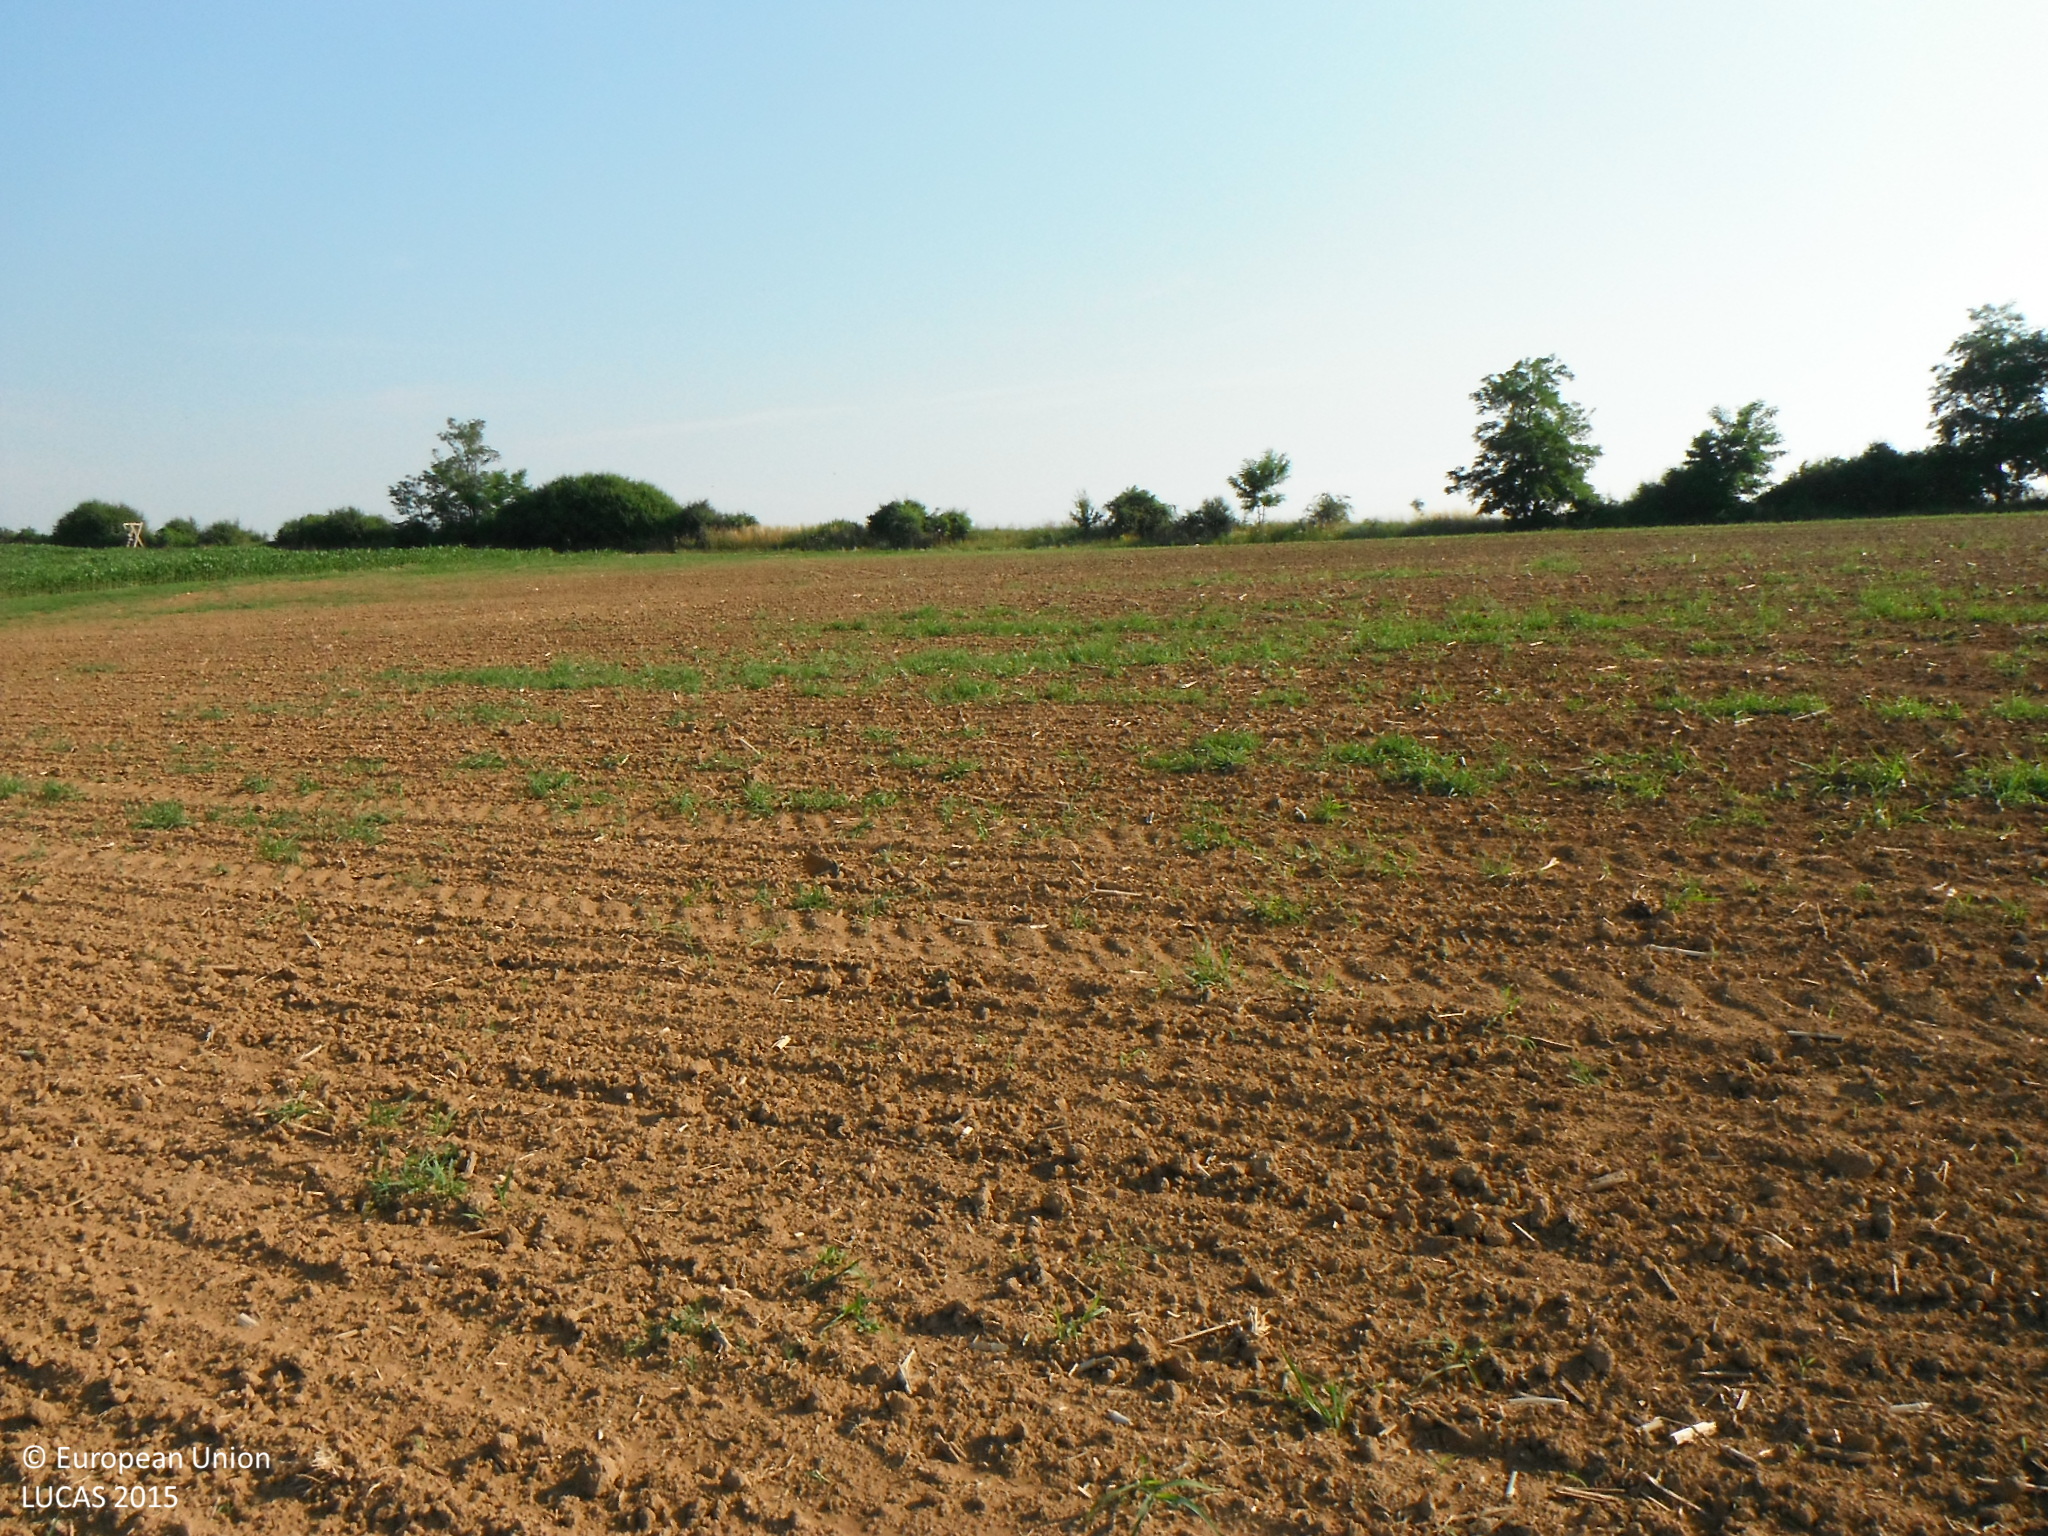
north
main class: Cropland
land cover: Maize
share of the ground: < 10 %
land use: Agriculture (excluding fallow land and kitchen gardens)
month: July
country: SK
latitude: 48.2325
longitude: 19.4613
